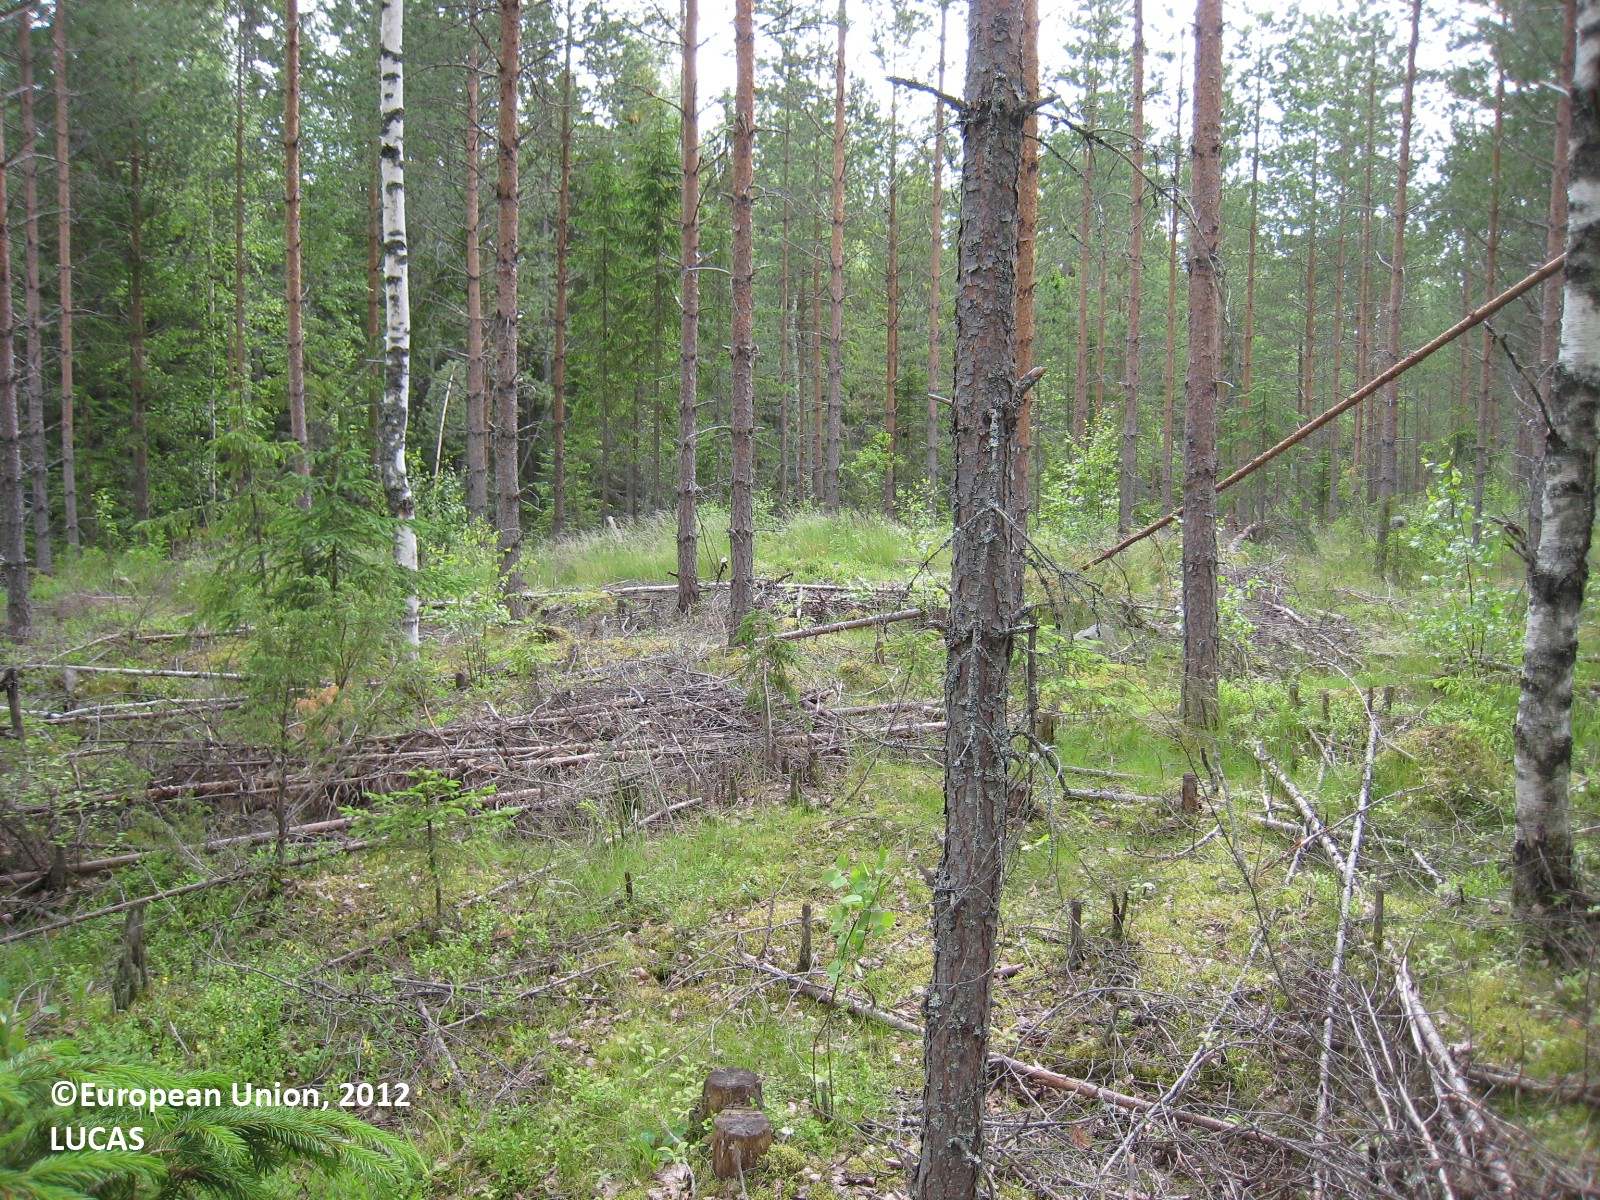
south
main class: Woodland
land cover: Pine dominated coniferous woodland
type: boreal forest
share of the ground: 50 - 75 %
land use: Forestry
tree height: > 5 m
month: June
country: FI
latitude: 62.1700
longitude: 26.3618
